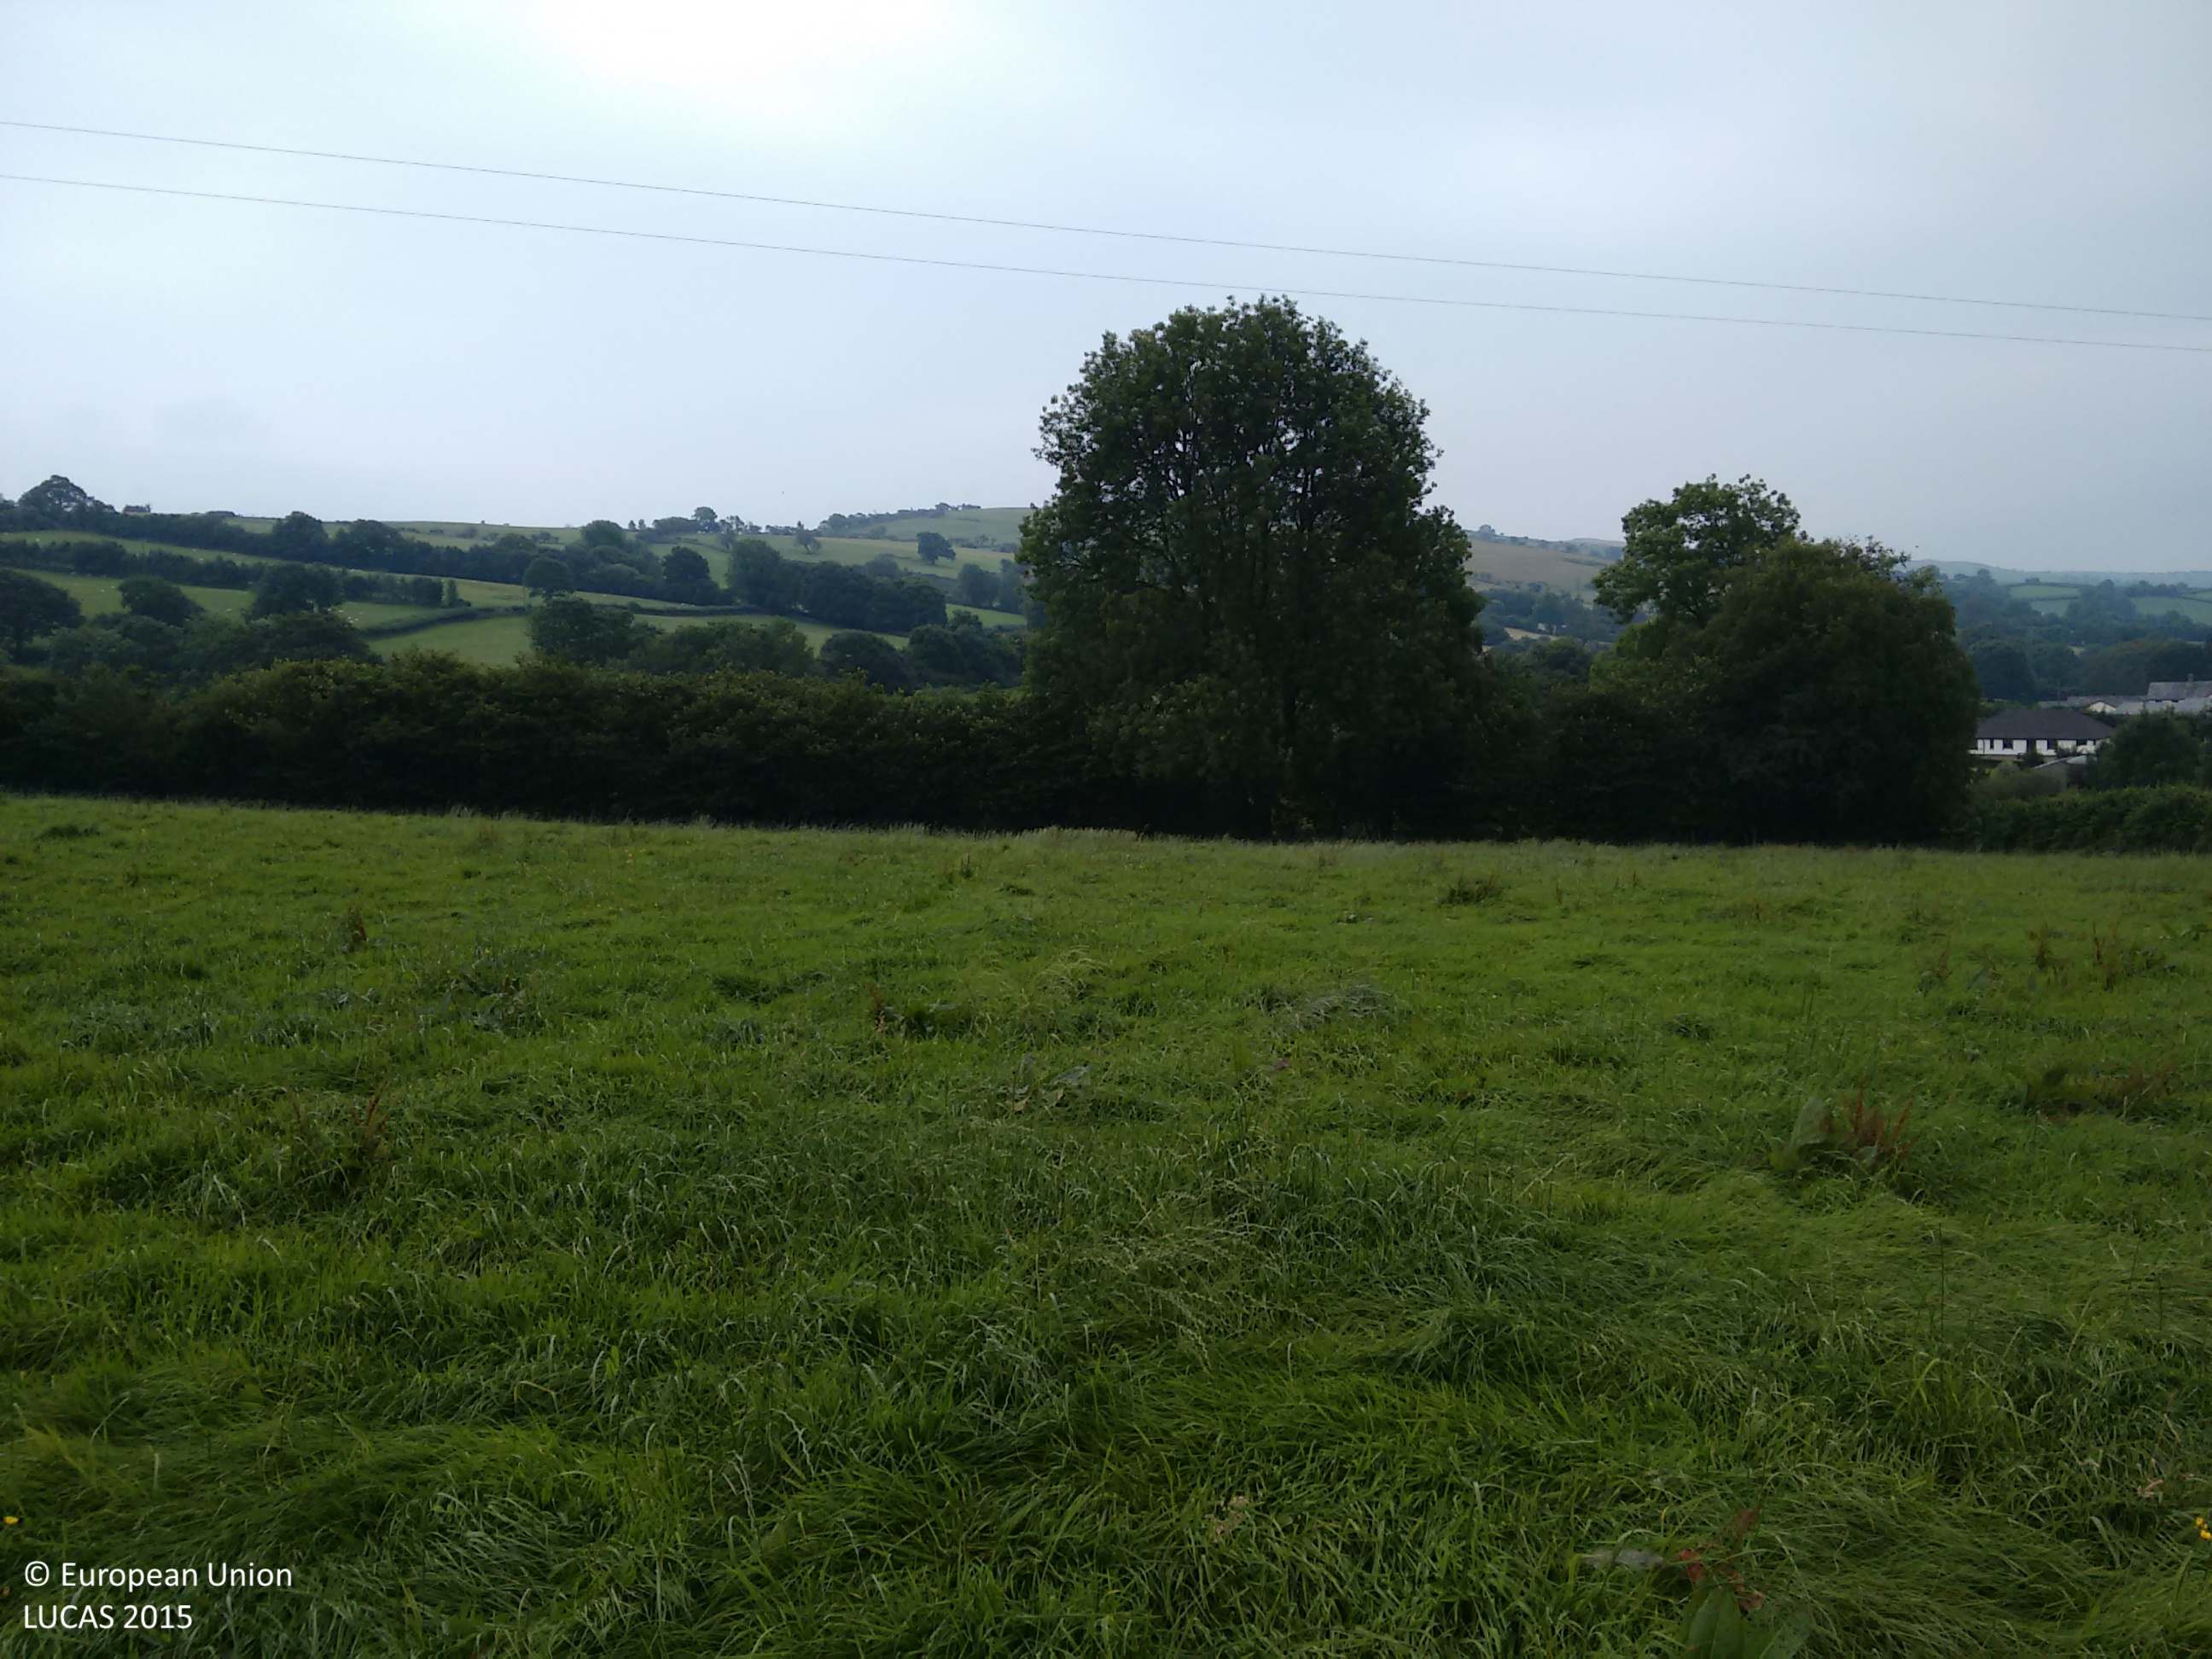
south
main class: Grassland
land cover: Grassland without tree/shrub cover
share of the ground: > 75 %
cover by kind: herbaceous plants 100 %
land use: Agriculture (excluding fallow land and kitchen gardens)
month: August
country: GB
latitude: 52.0437
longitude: -3.9296
